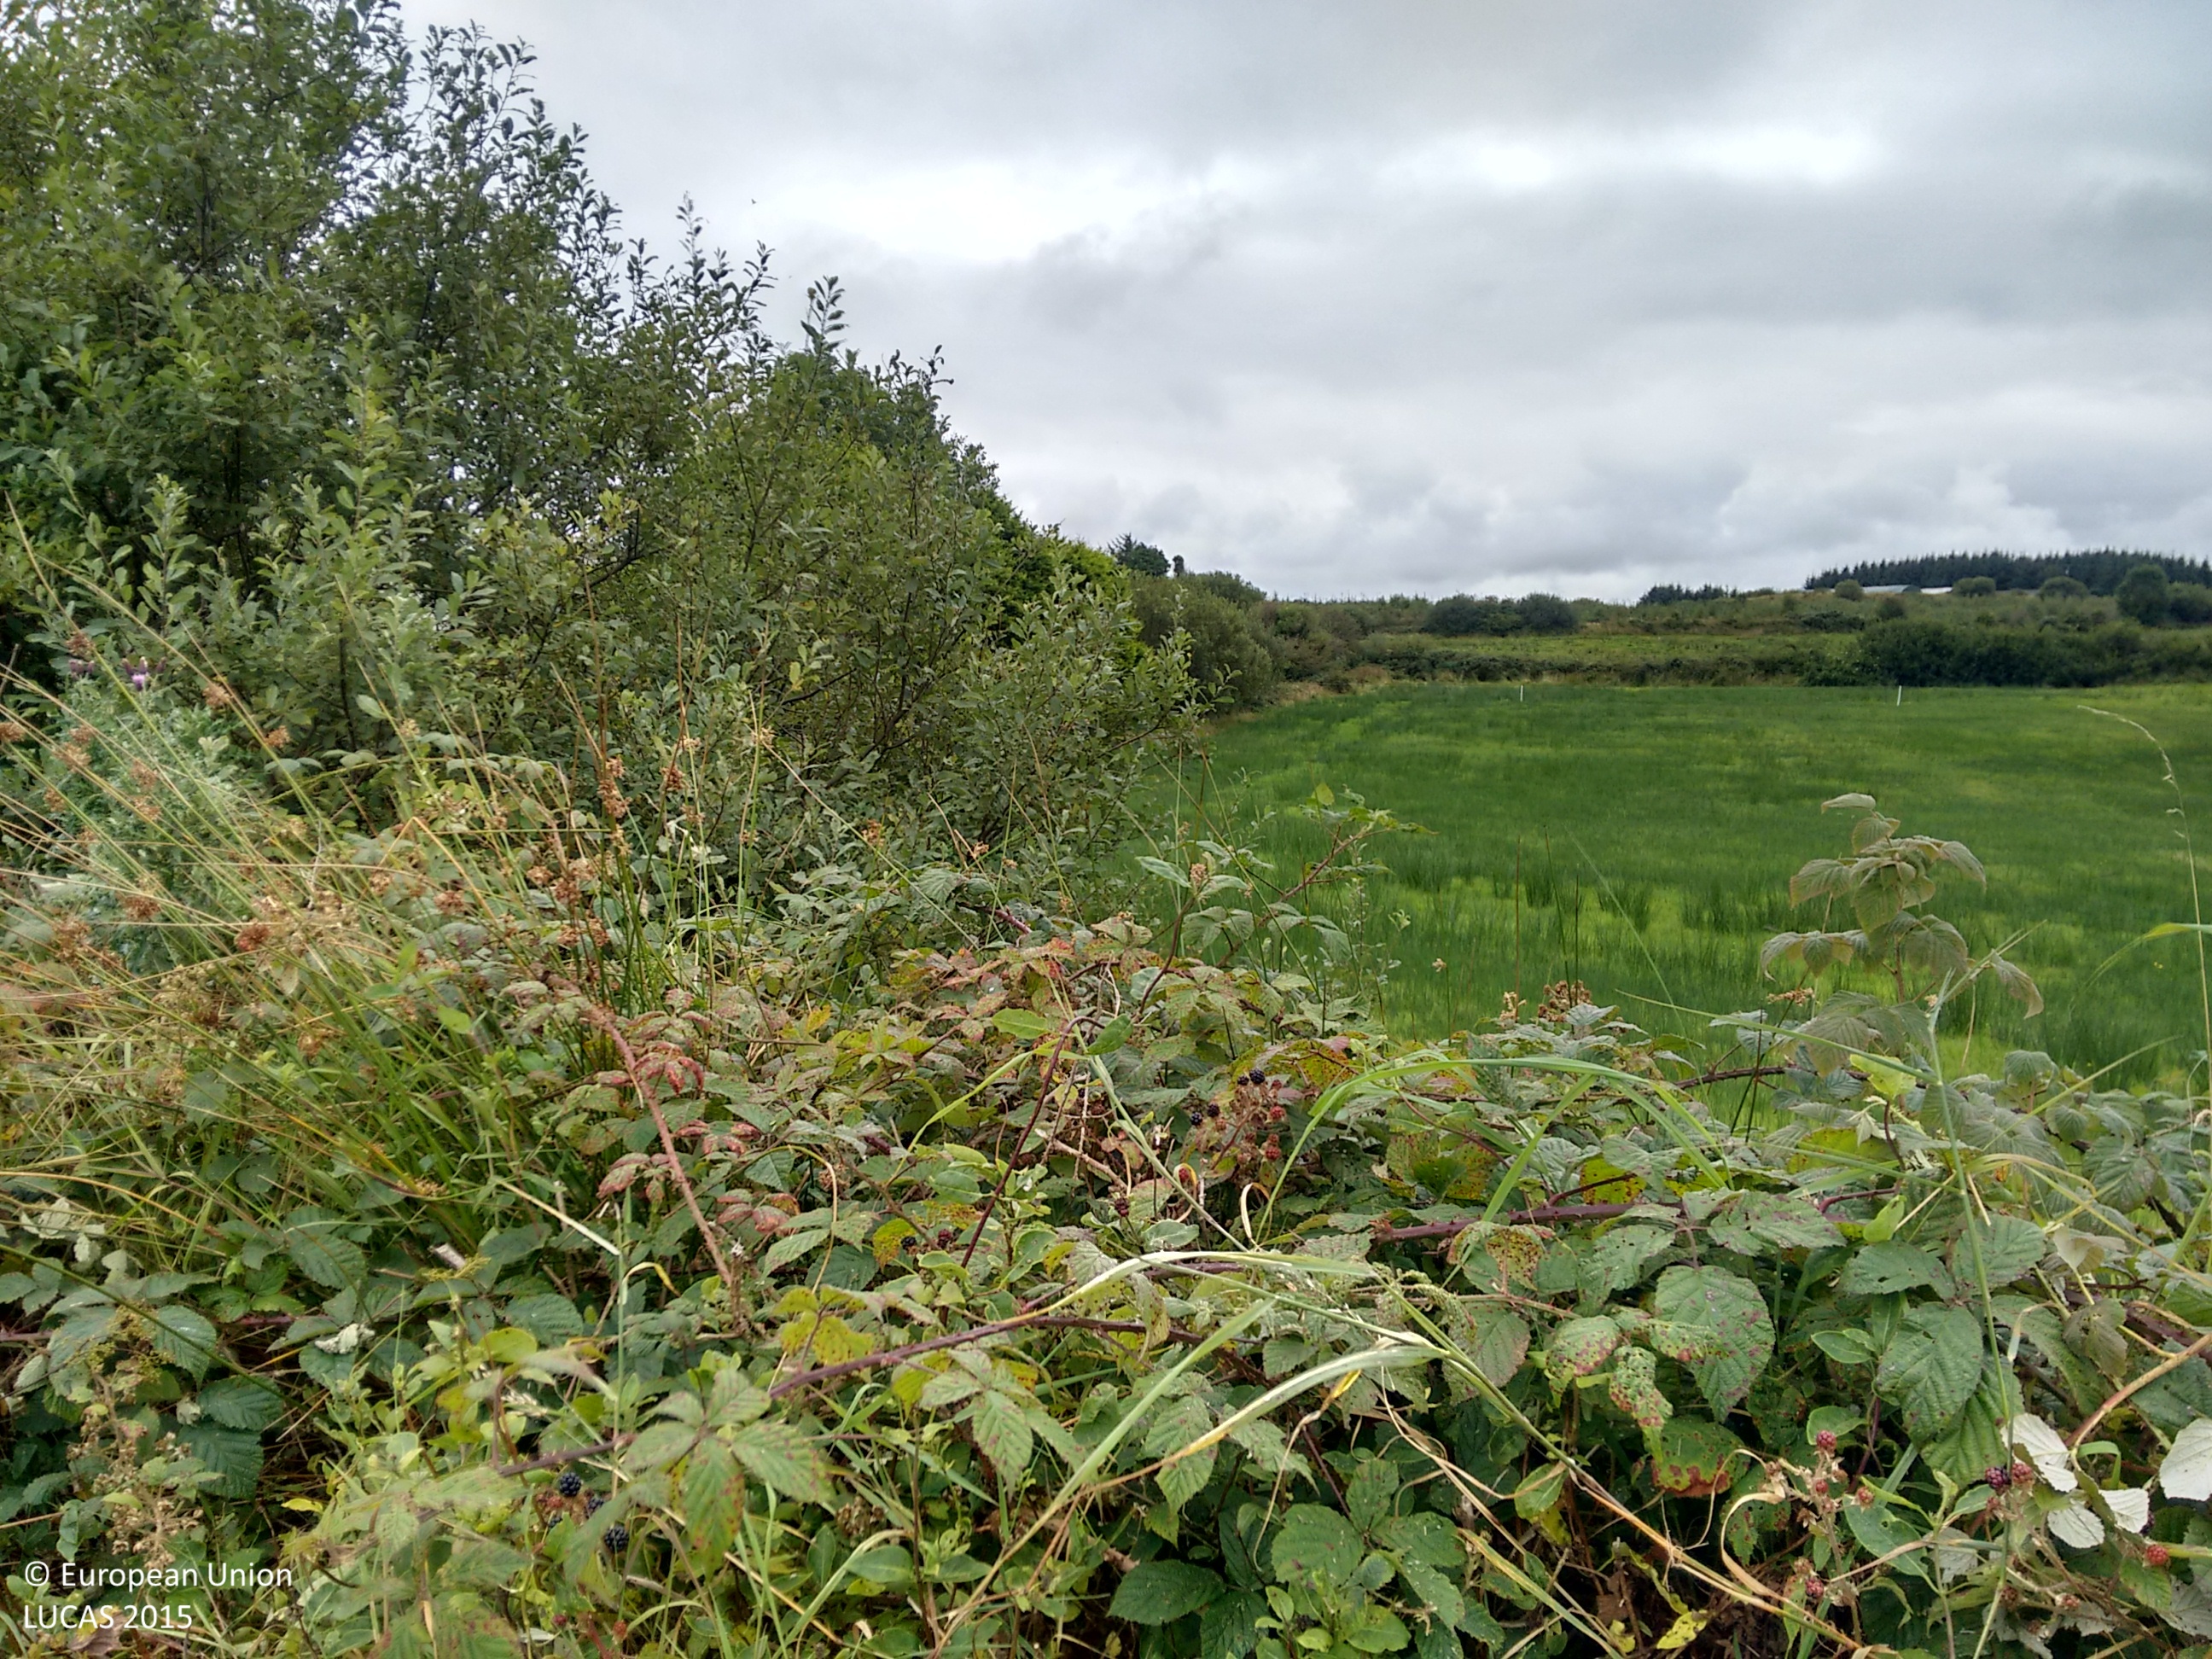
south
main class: Grassland
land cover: Grassland without tree/shrub cover
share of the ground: > 75 %
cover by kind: herbaceous plants 100 %
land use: Agriculture (excluding fallow land and kitchen gardens)
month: September
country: IE
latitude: 52.8338
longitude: -9.1442
